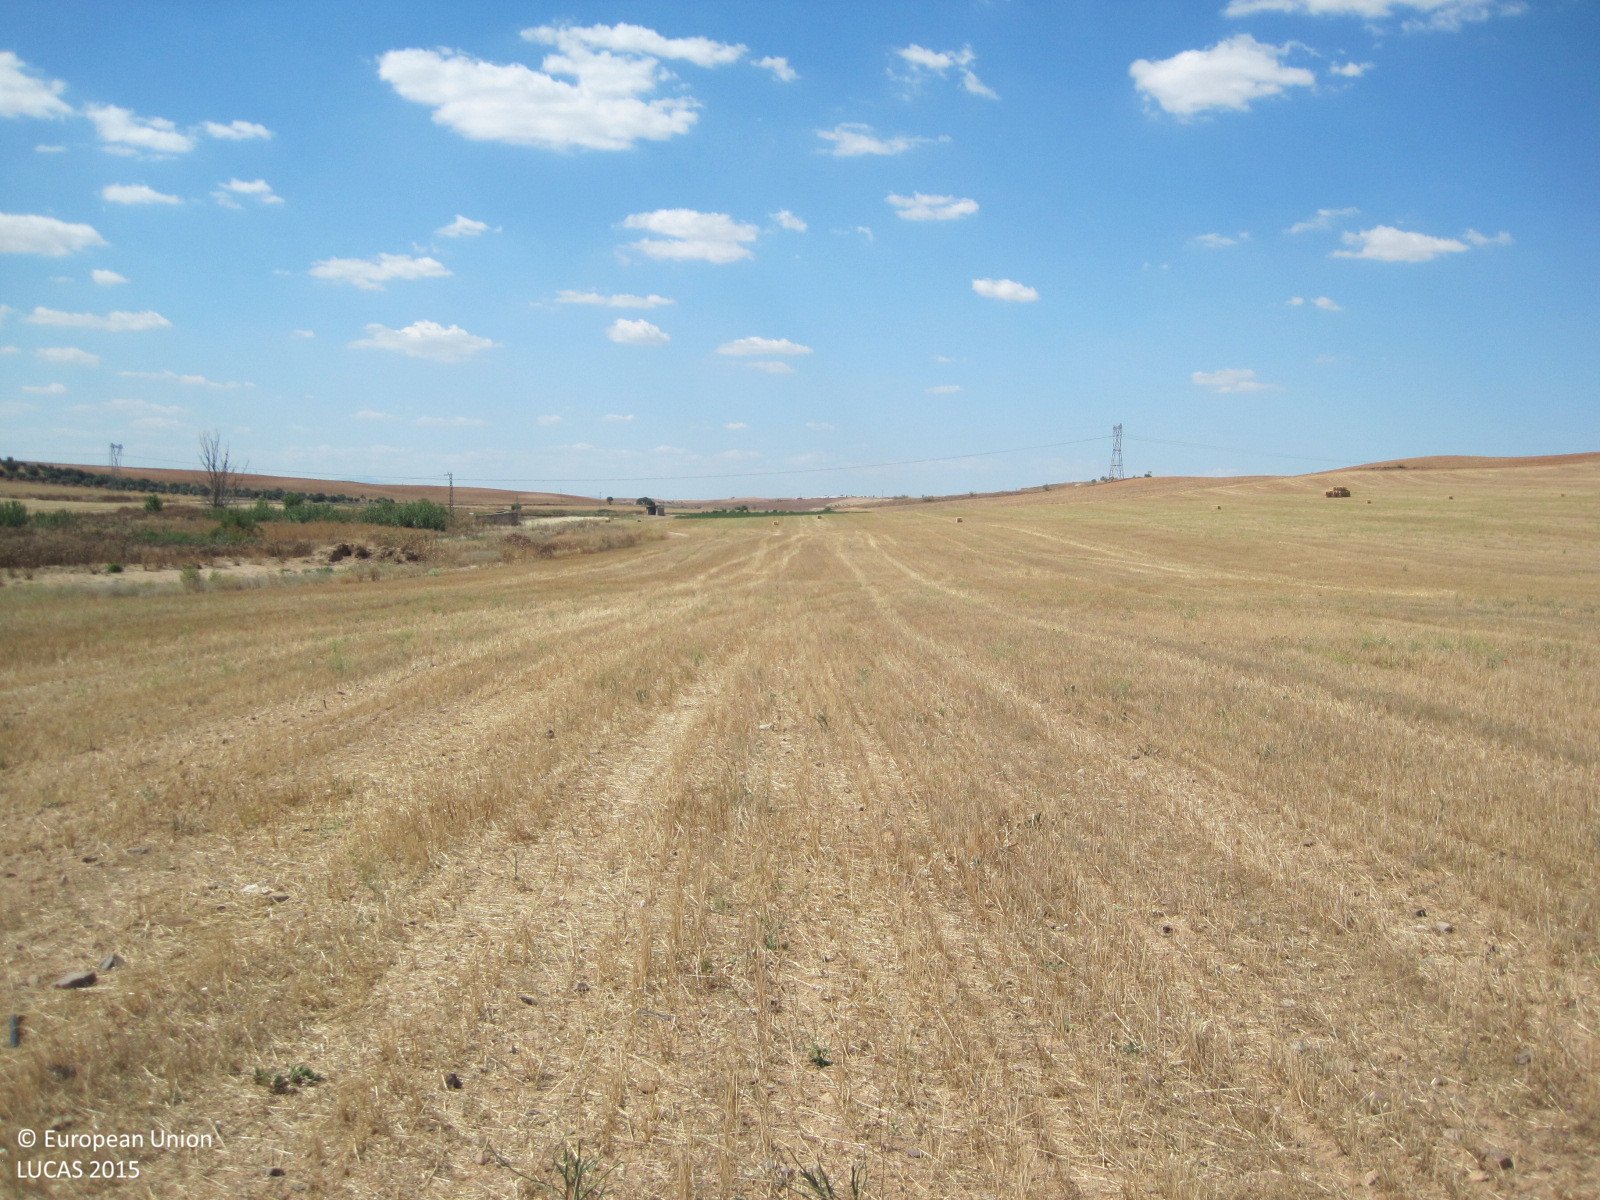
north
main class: Cropland
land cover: Oats
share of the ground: < 10 %
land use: Agriculture (excluding fallow land and kitchen gardens)
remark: Harvested field
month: June
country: ES
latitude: 39.9034
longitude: -4.2260
